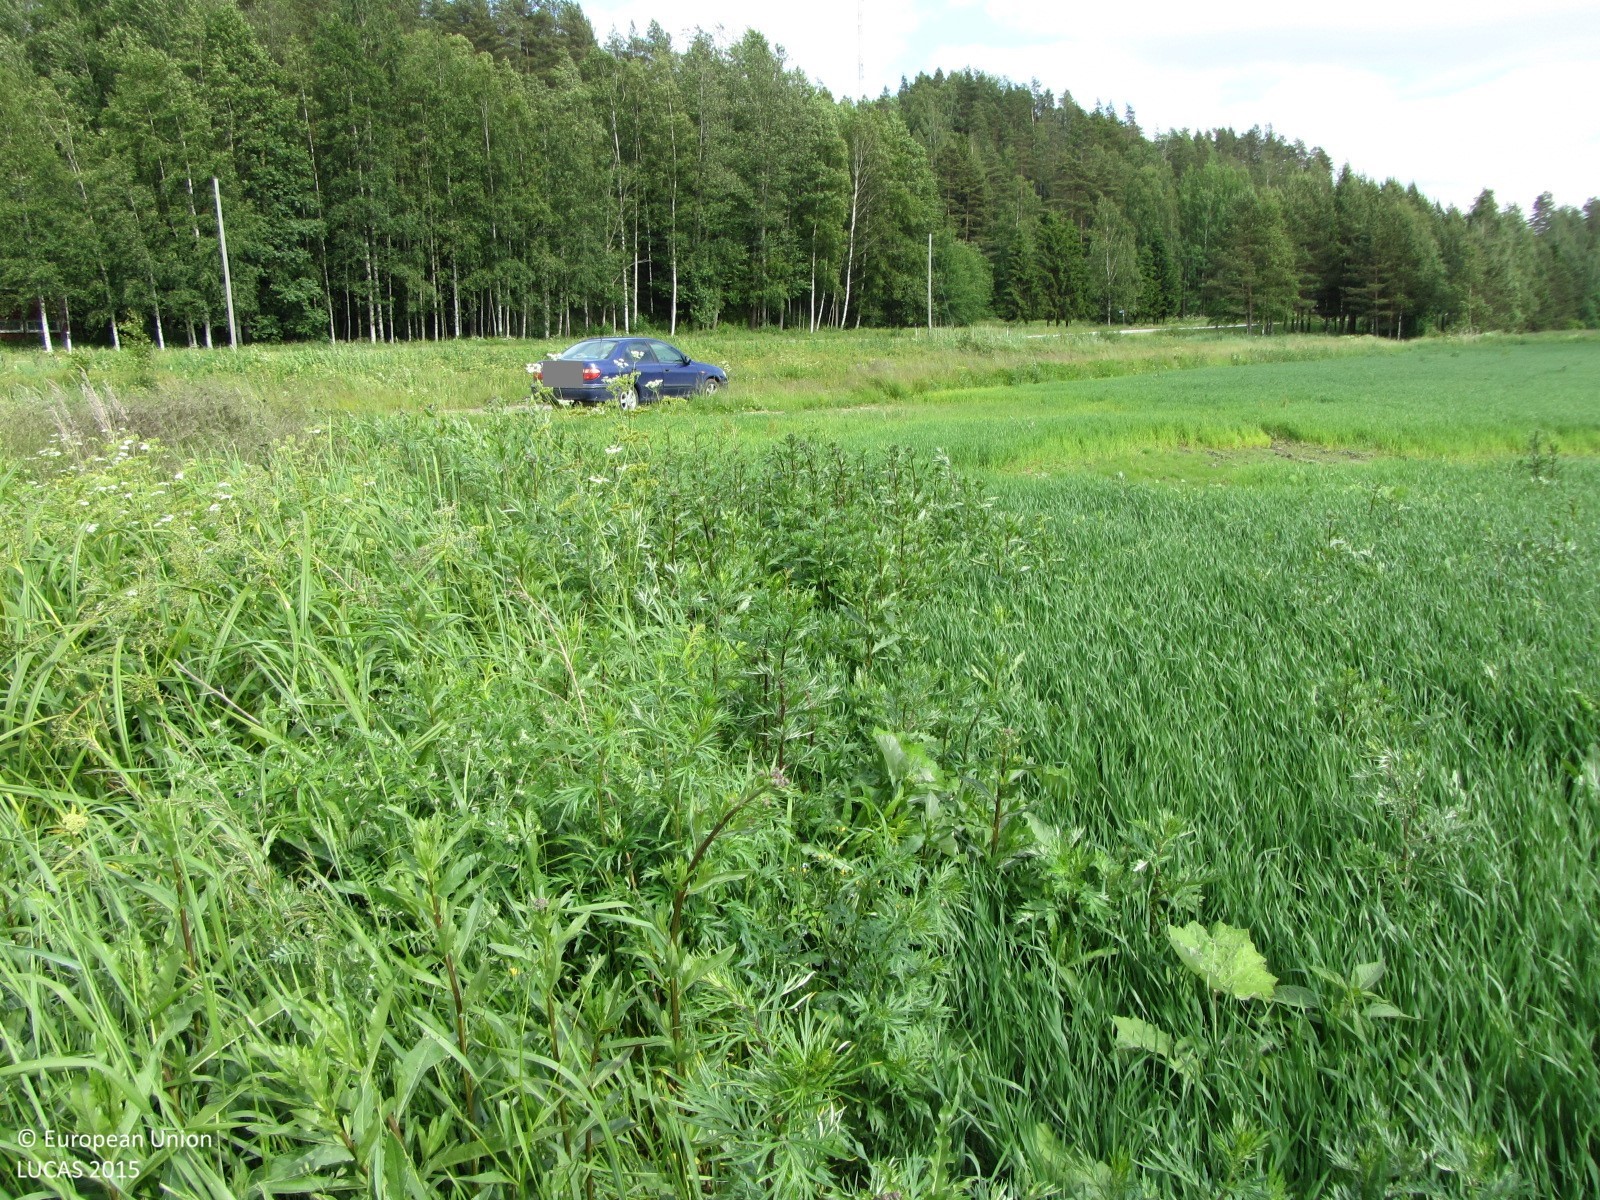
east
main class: Cropland
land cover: Common wheat
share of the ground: > 75 %
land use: Agriculture (excluding fallow land and kitchen gardens)
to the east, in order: Common wheat
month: June
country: FI
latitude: 60.0847
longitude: 23.2252
